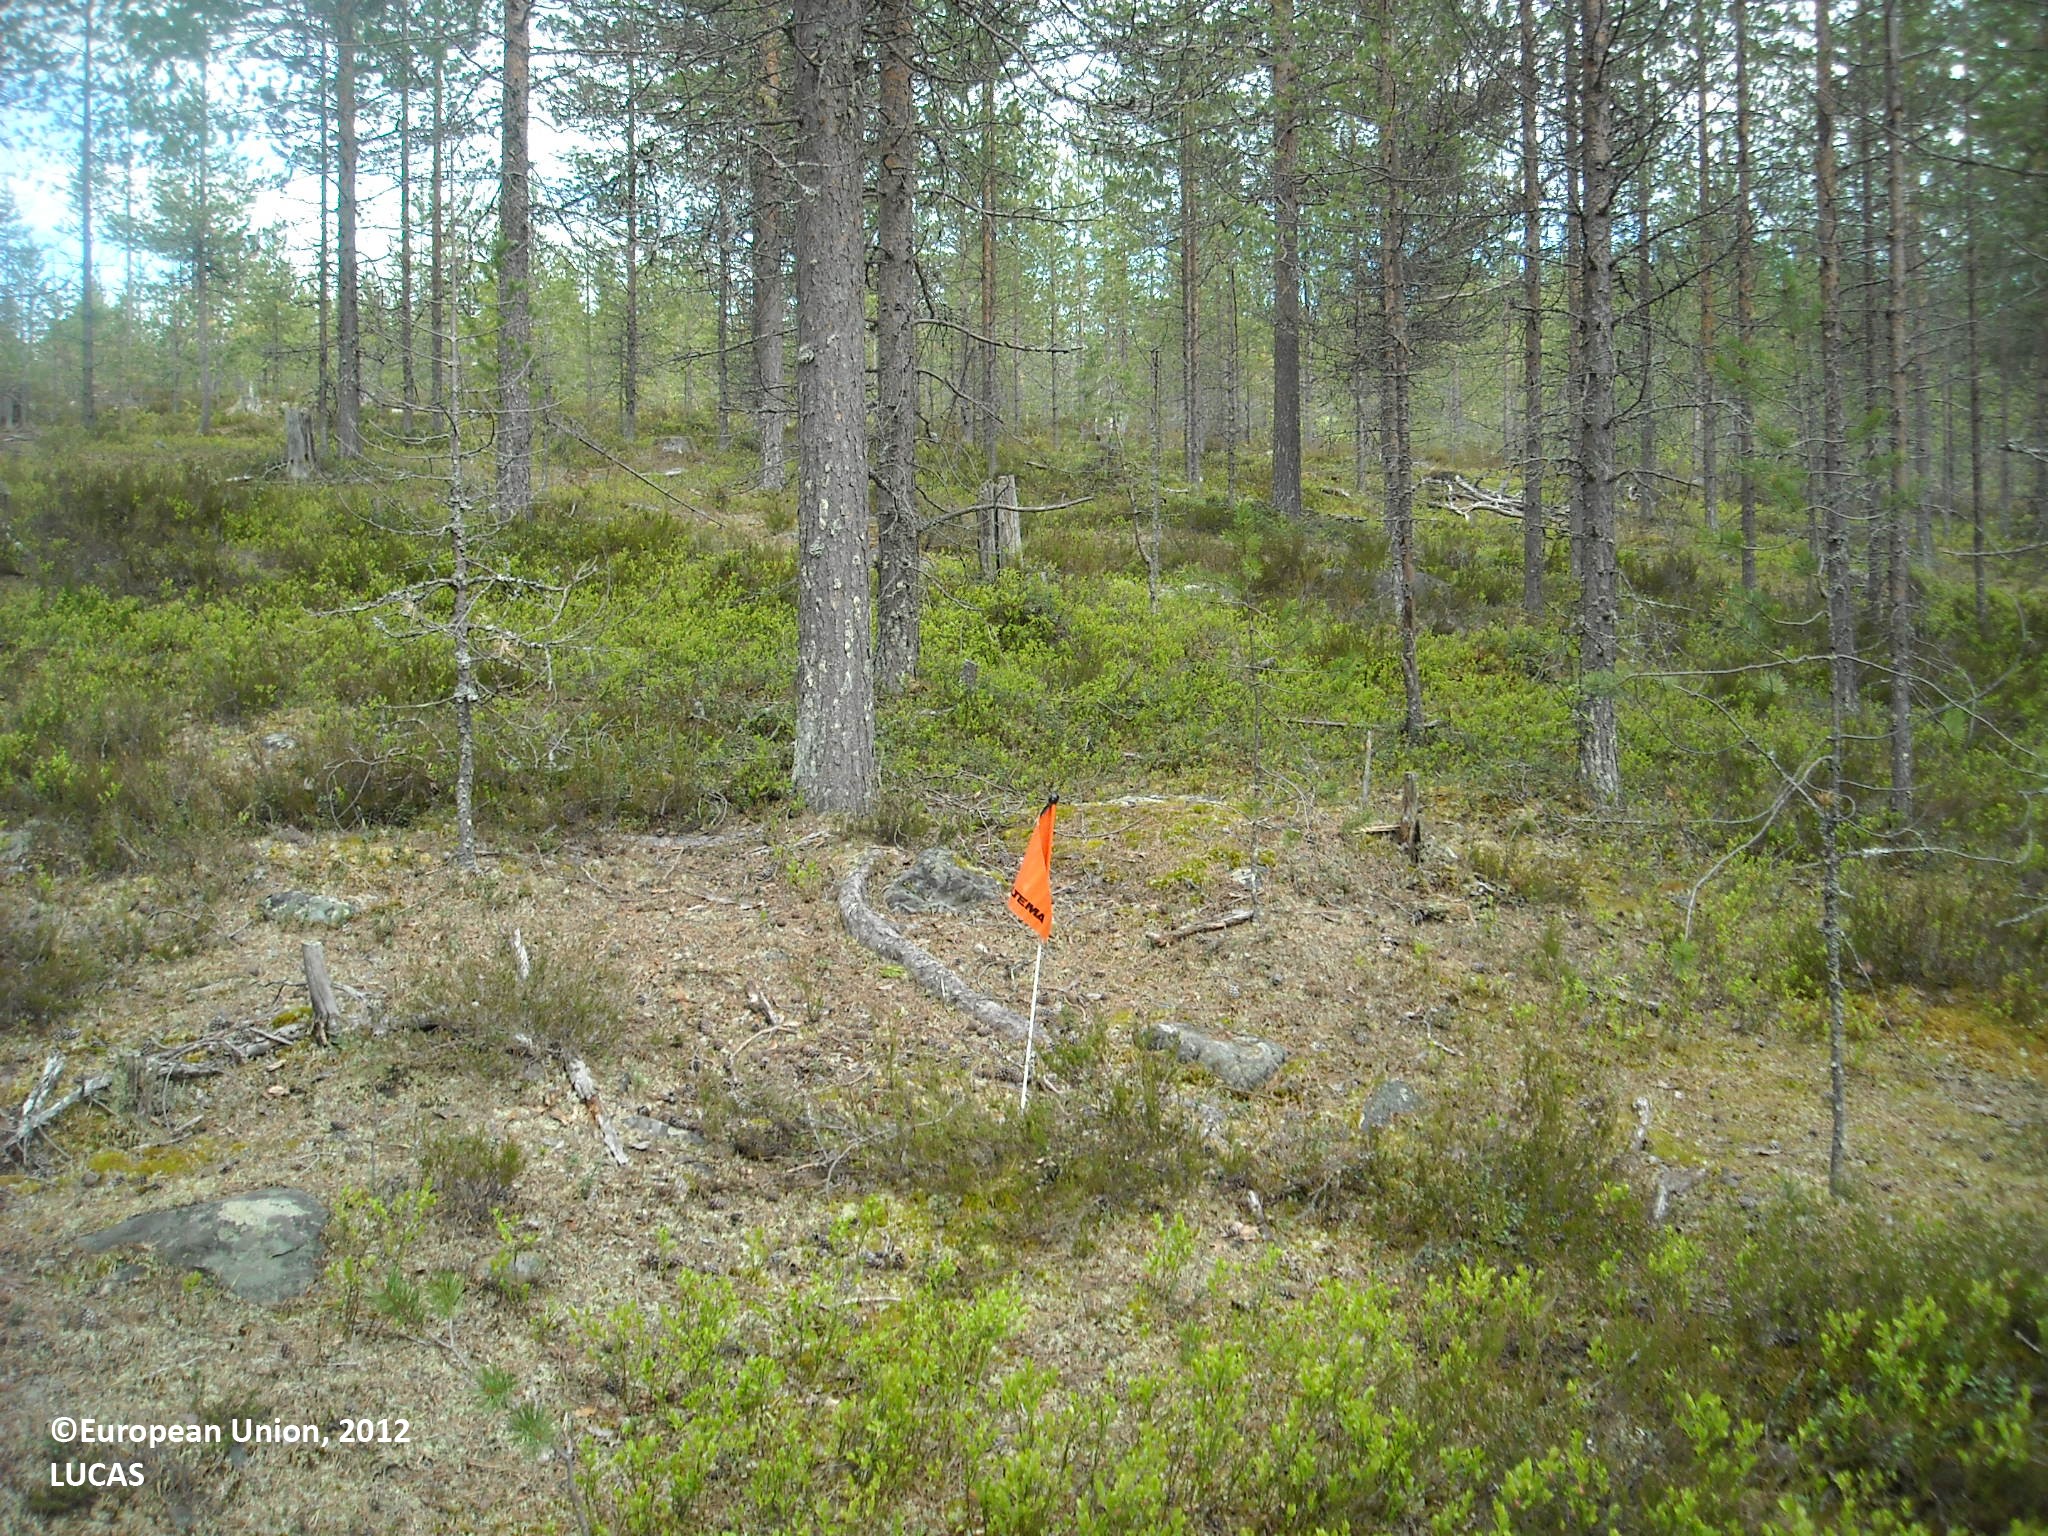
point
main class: Woodland
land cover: Pine dominated coniferous woodland
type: boreal forest
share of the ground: > 75 %
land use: Forestry
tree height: > 5 m
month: June
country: FI
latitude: 65.2343
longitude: 27.7039
